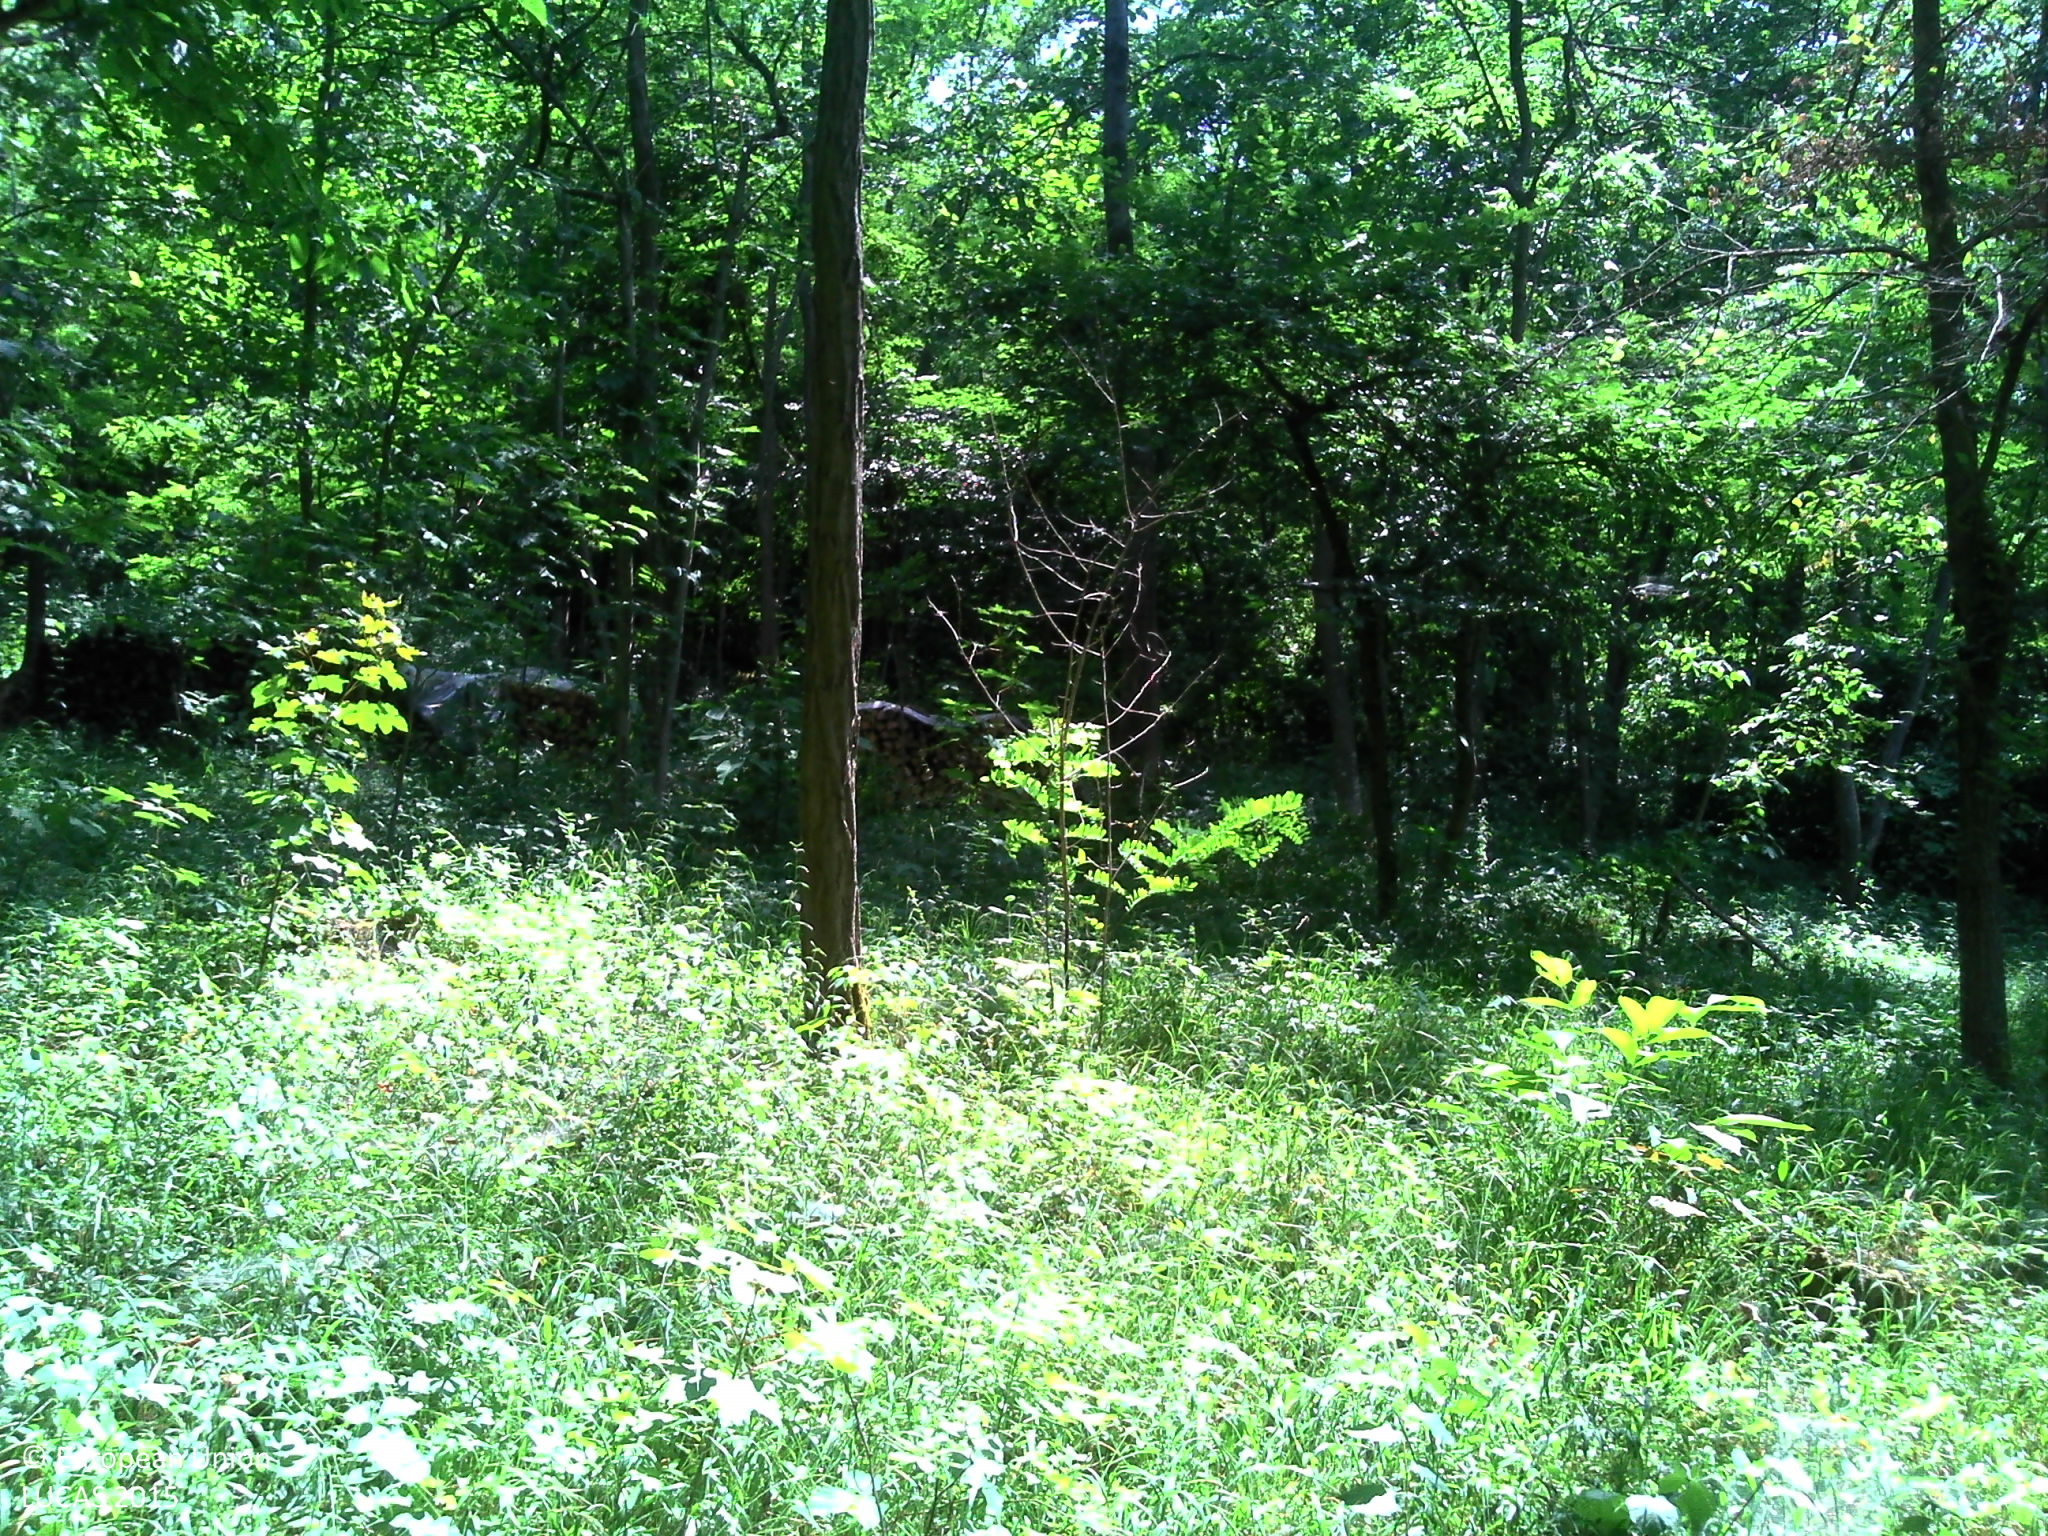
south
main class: Woodland
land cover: Broadleaved woodland
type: mesophytic deciduous forest
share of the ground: > 75 %
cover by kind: broadleaved forest trees 85 %, herbaceous plants 15 %
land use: Forestry
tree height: > 5 m
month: July
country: FR
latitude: 48.5545
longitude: 7.4673
